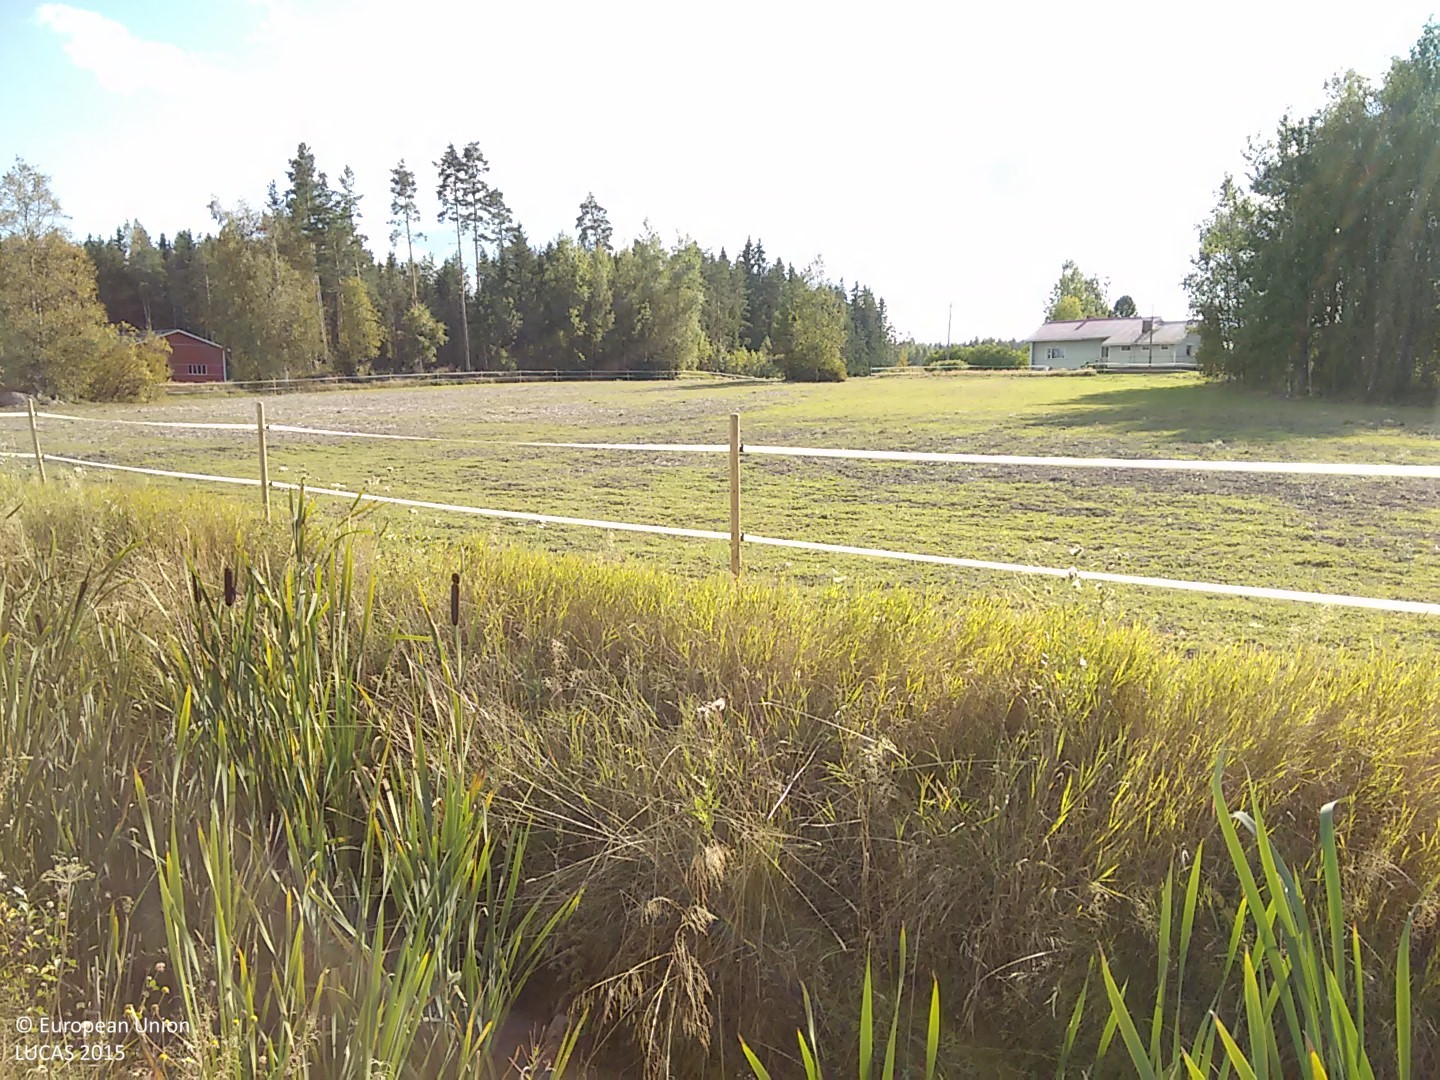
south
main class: Cropland
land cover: Oats
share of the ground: > 75 %
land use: Agriculture (excluding fallow land and kitchen gardens)
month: September
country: FI
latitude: 60.9643
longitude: 21.7485
